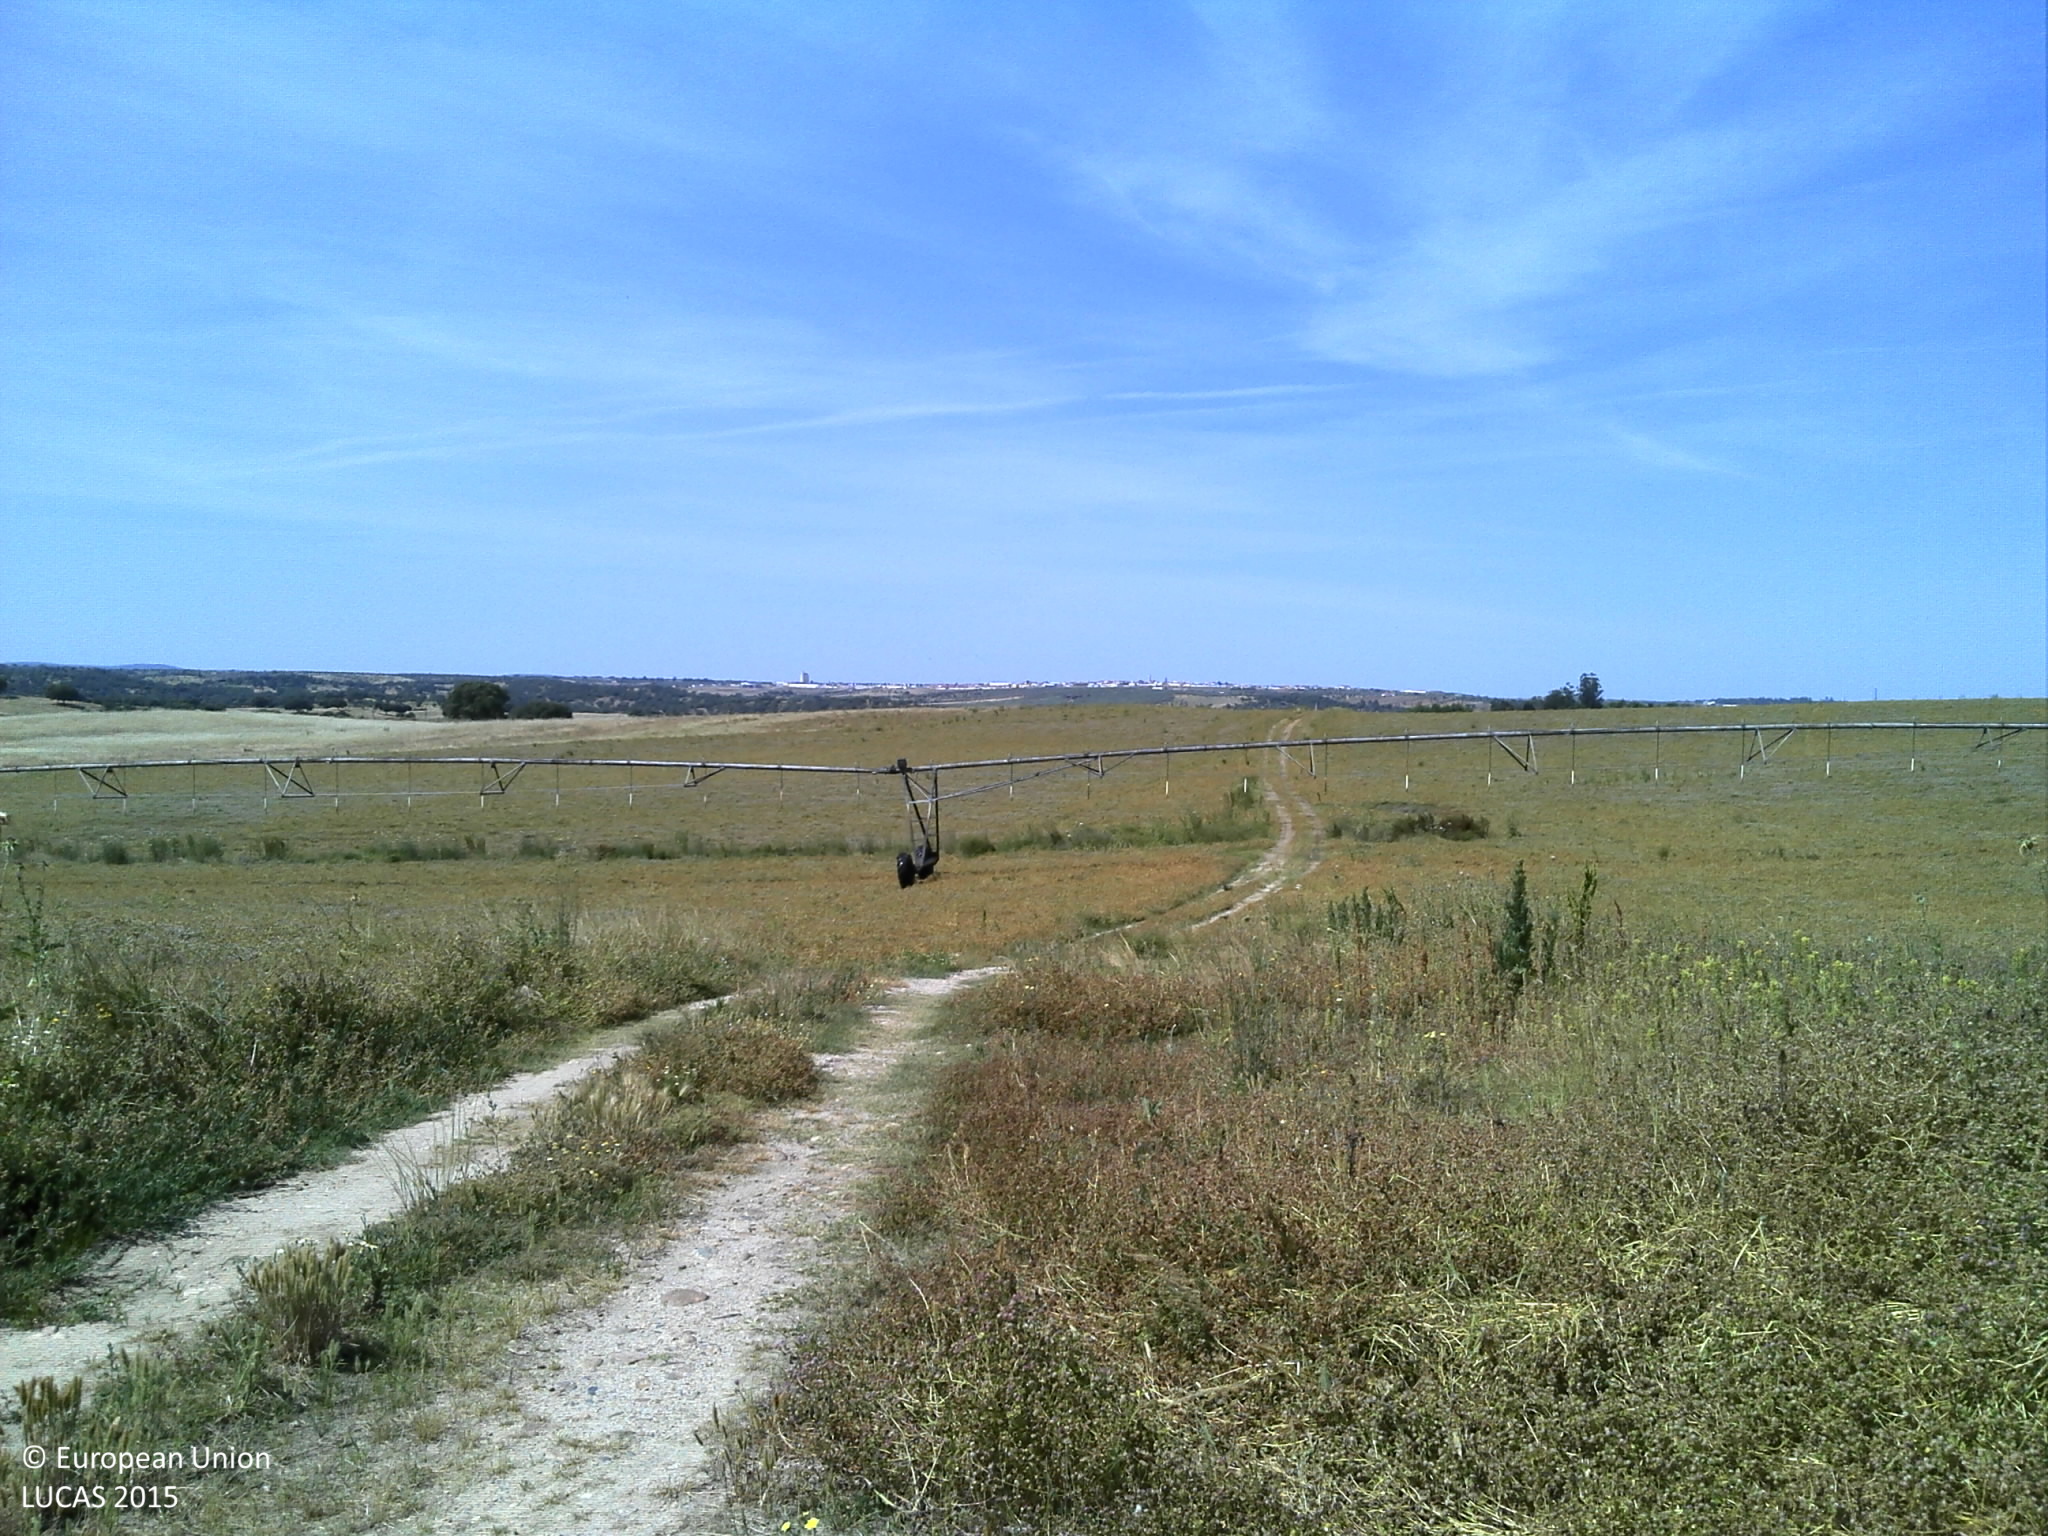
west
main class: Cropland
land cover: Clovers
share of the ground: > 75 %
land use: Agriculture (excluding fallow land and kitchen gardens)
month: May
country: PT
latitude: 39.0864
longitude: -7.6026
